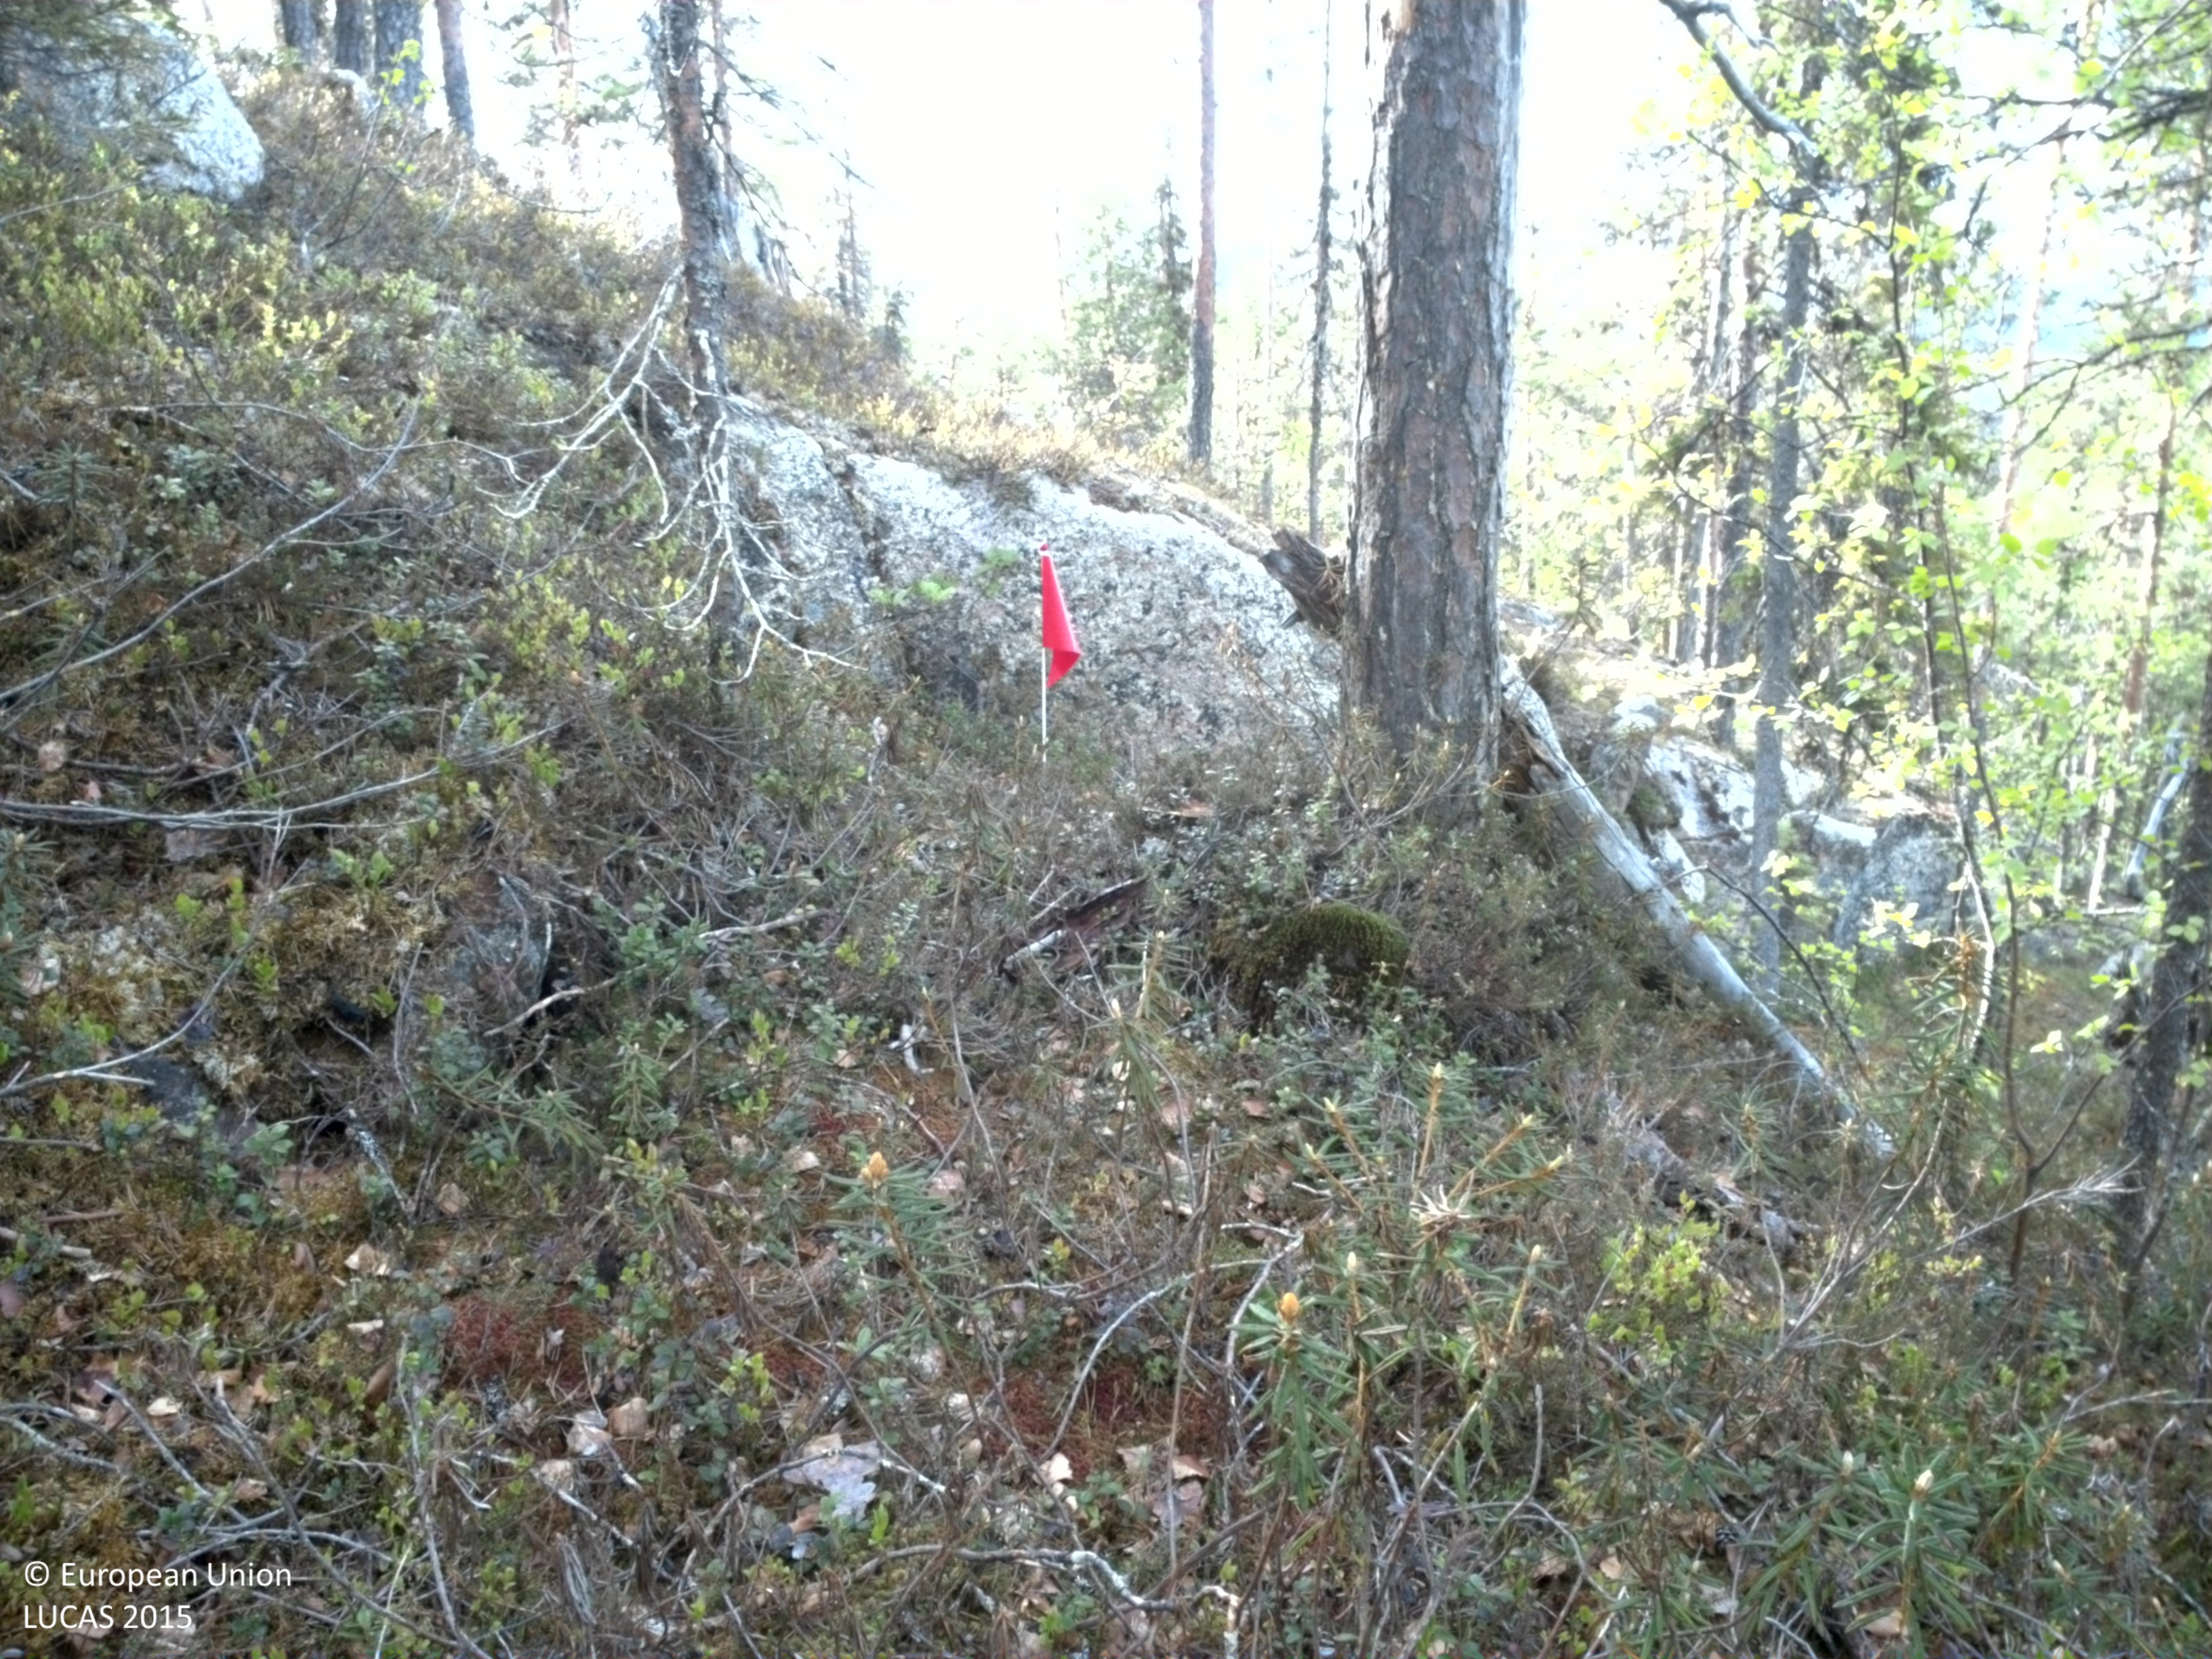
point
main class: Woodland
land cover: Pine dominated coniferous woodland
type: boreal forest
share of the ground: 50 - 75 %
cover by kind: coniferous forest trees 50 %, shrubs 40 %, broadleaved forest trees 5 %, consolidated bare surface 5 %
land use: Semi-natural and natural areas not in use
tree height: > 5 m
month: June
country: SE
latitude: 66.4634
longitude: 22.6077
